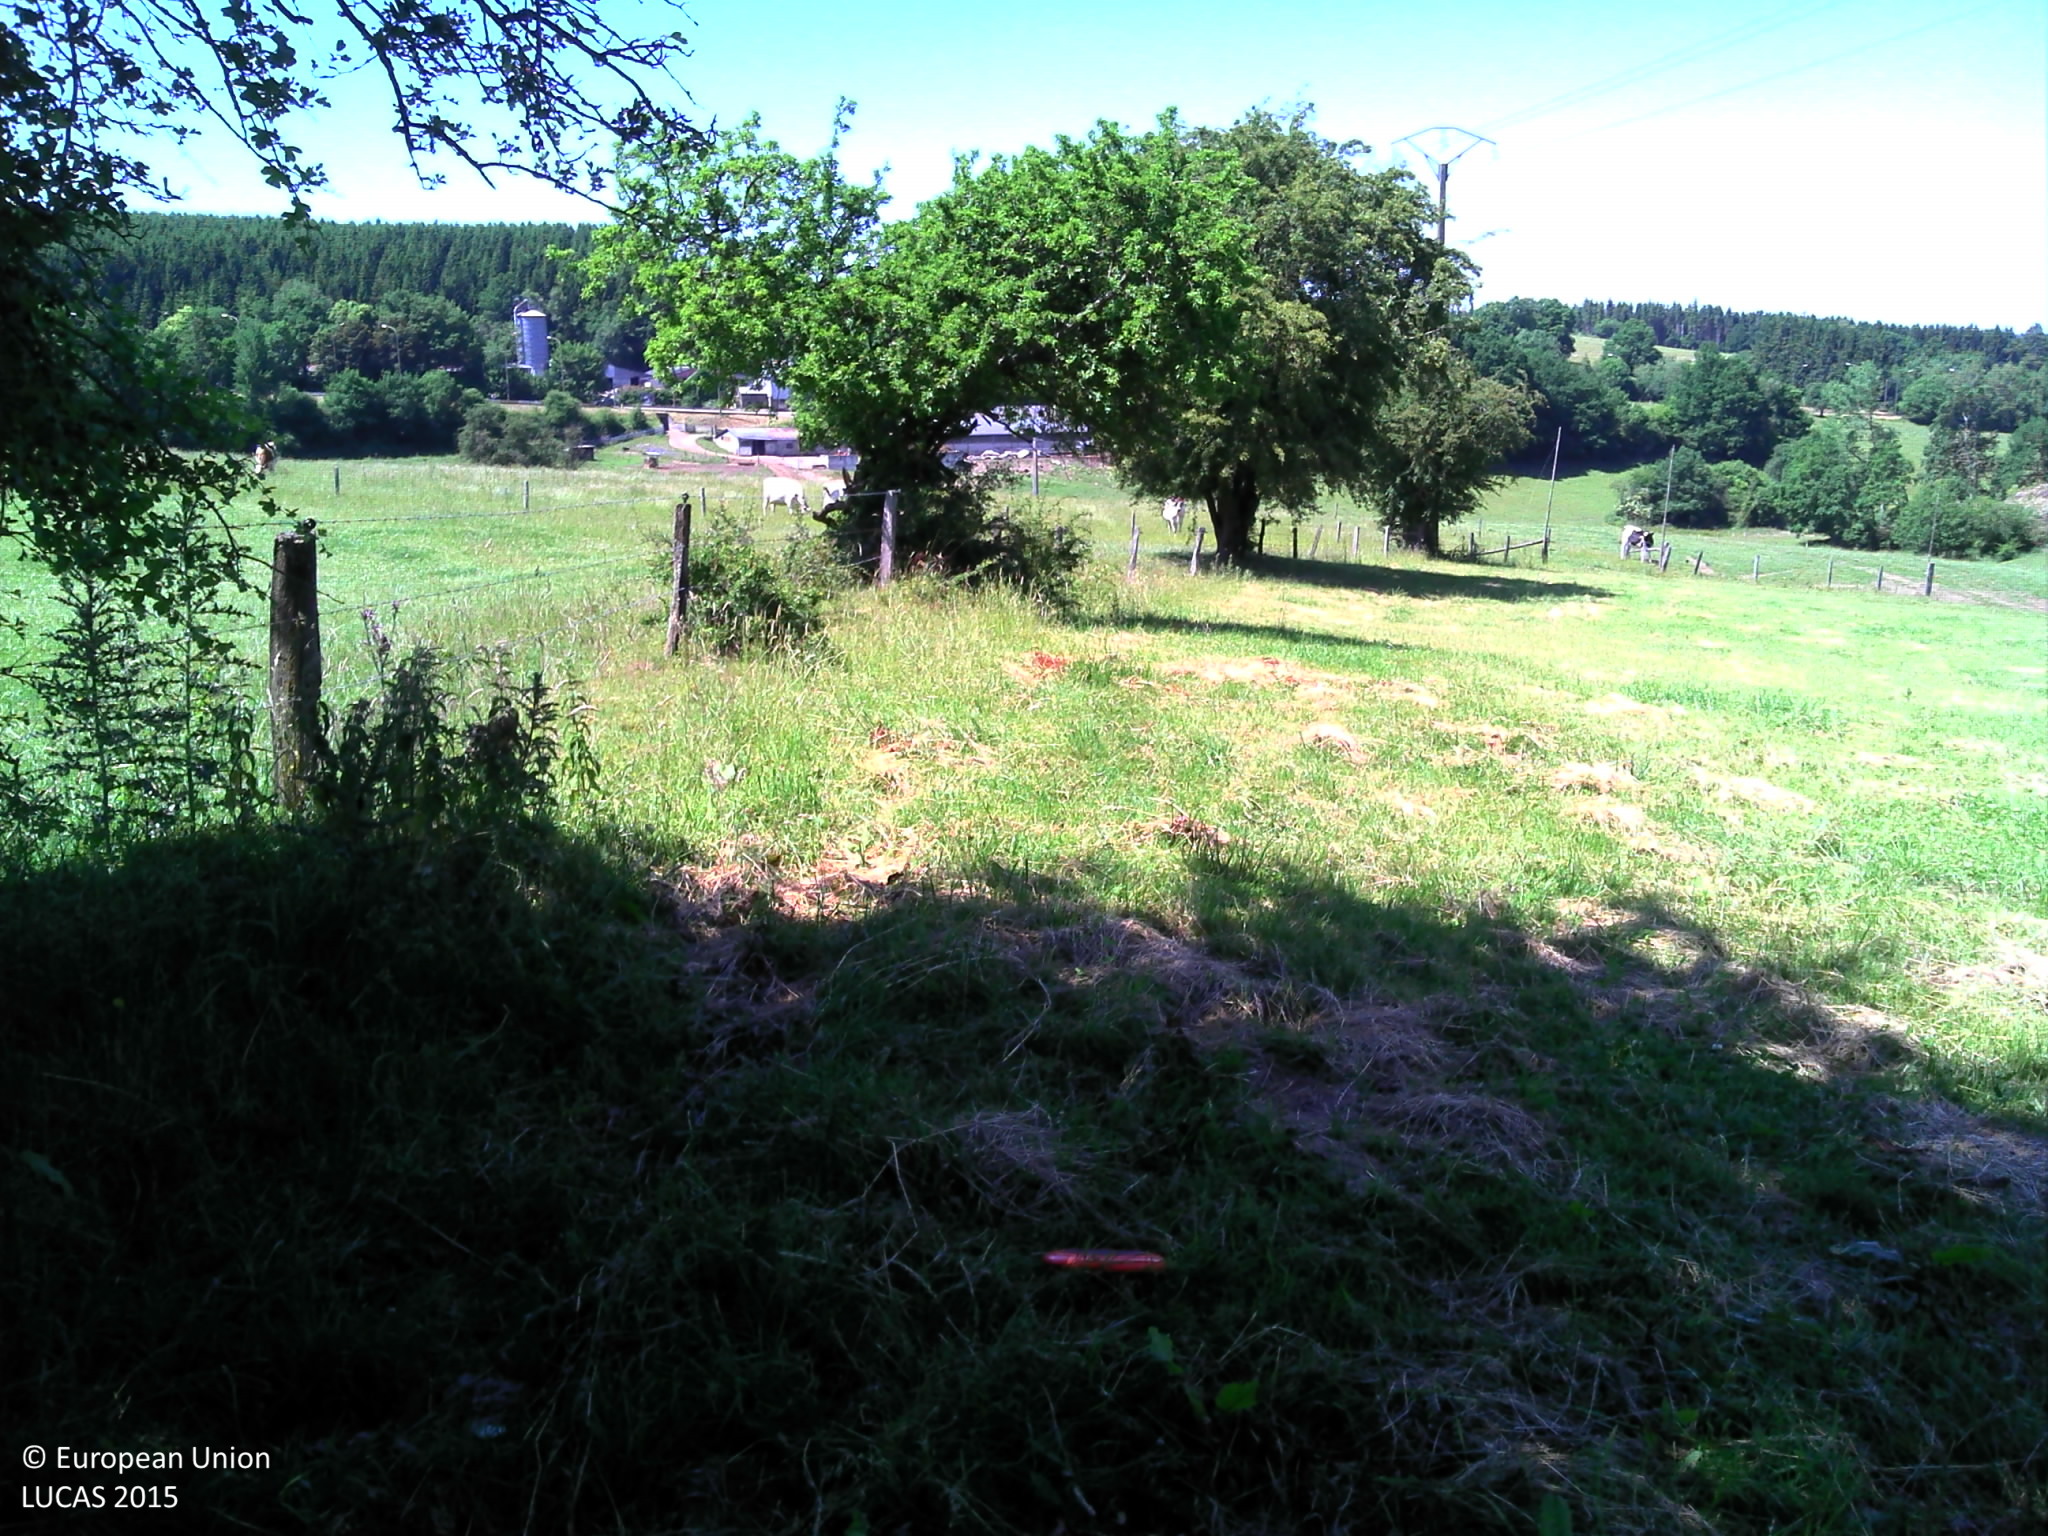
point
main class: Grassland
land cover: Grassland without tree/shrub cover
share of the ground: > 75 %
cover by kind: herbaceous plants 100 %
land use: Agriculture (excluding fallow land and kitchen gardens)
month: June
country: BE
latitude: 50.0611
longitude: 5.5423
